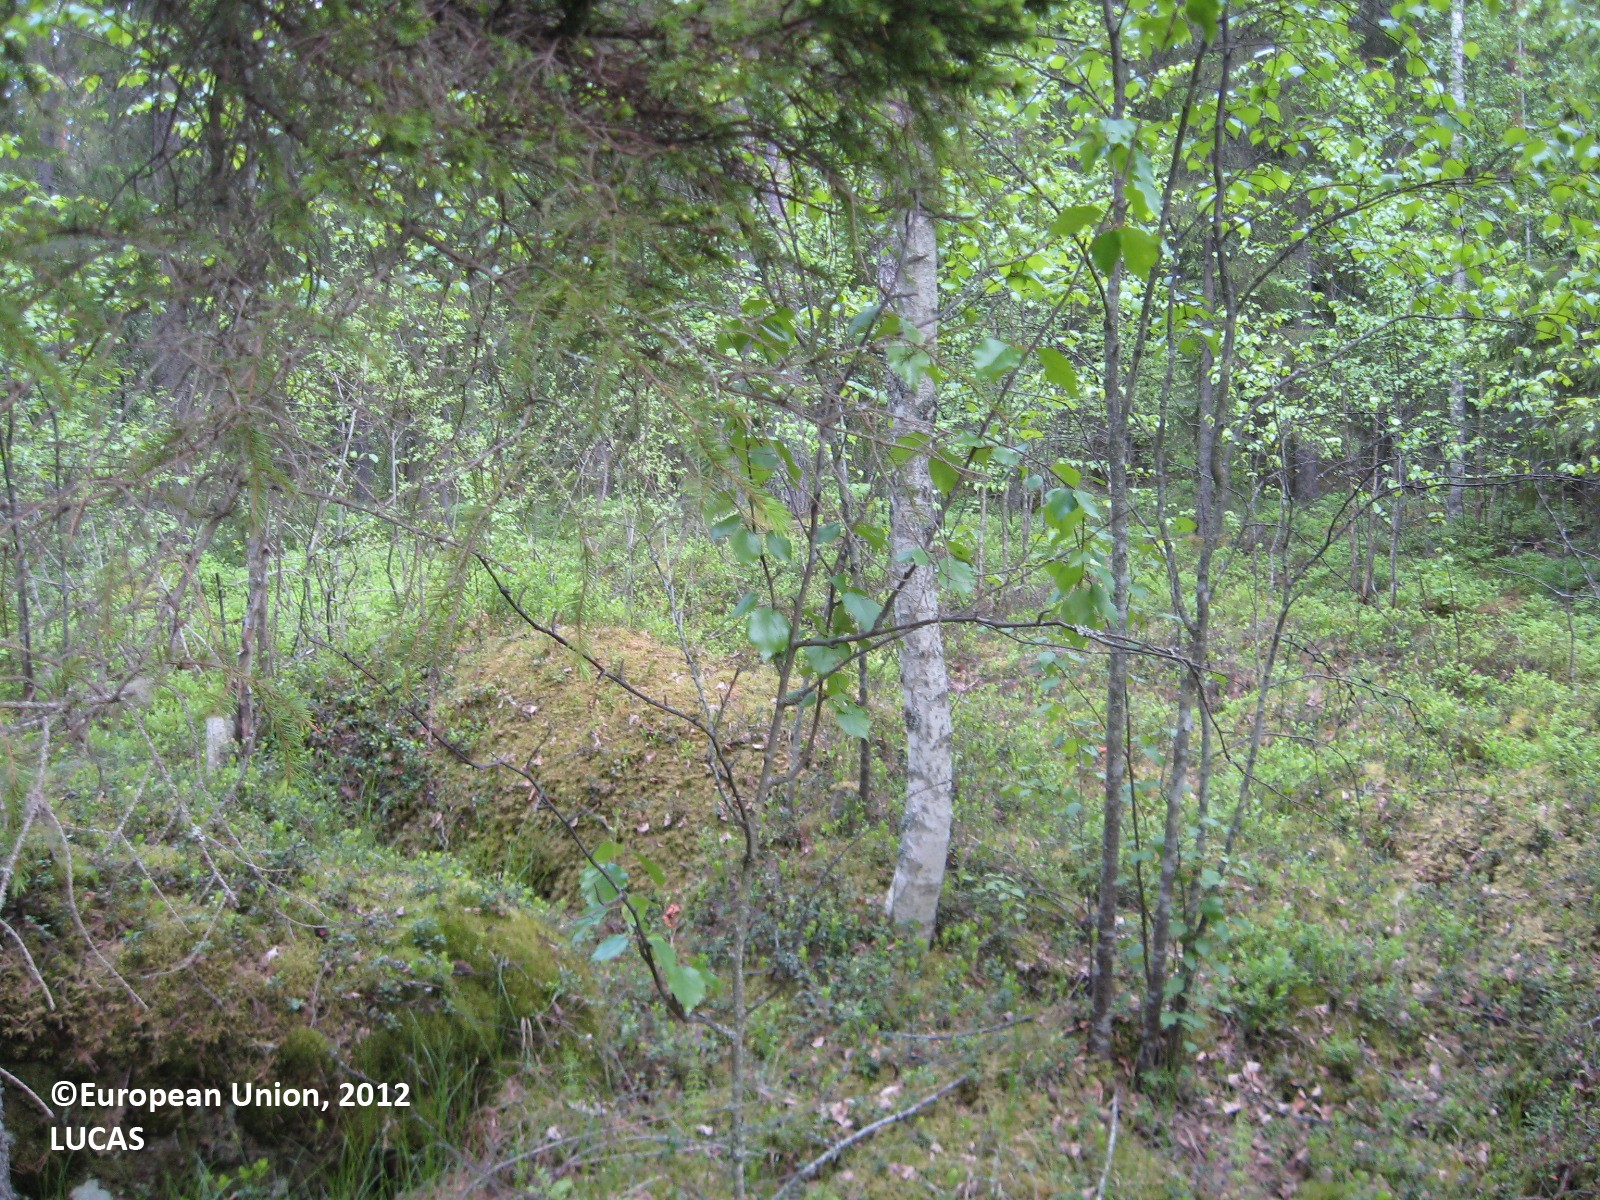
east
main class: Woodland
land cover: Spruce dominated mixed woodland
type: boreal forest
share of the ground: > 75 %
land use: Forestry
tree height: > 5 m
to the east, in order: Spruce dominated mixed woodland; Ditches and canals; Spruce dominated mixed woodland; Ditches and canals; Spruce dominated mixed woodland; Pine dominated mixed woodland
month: June
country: FI
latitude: 63.0579
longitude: 22.7351
